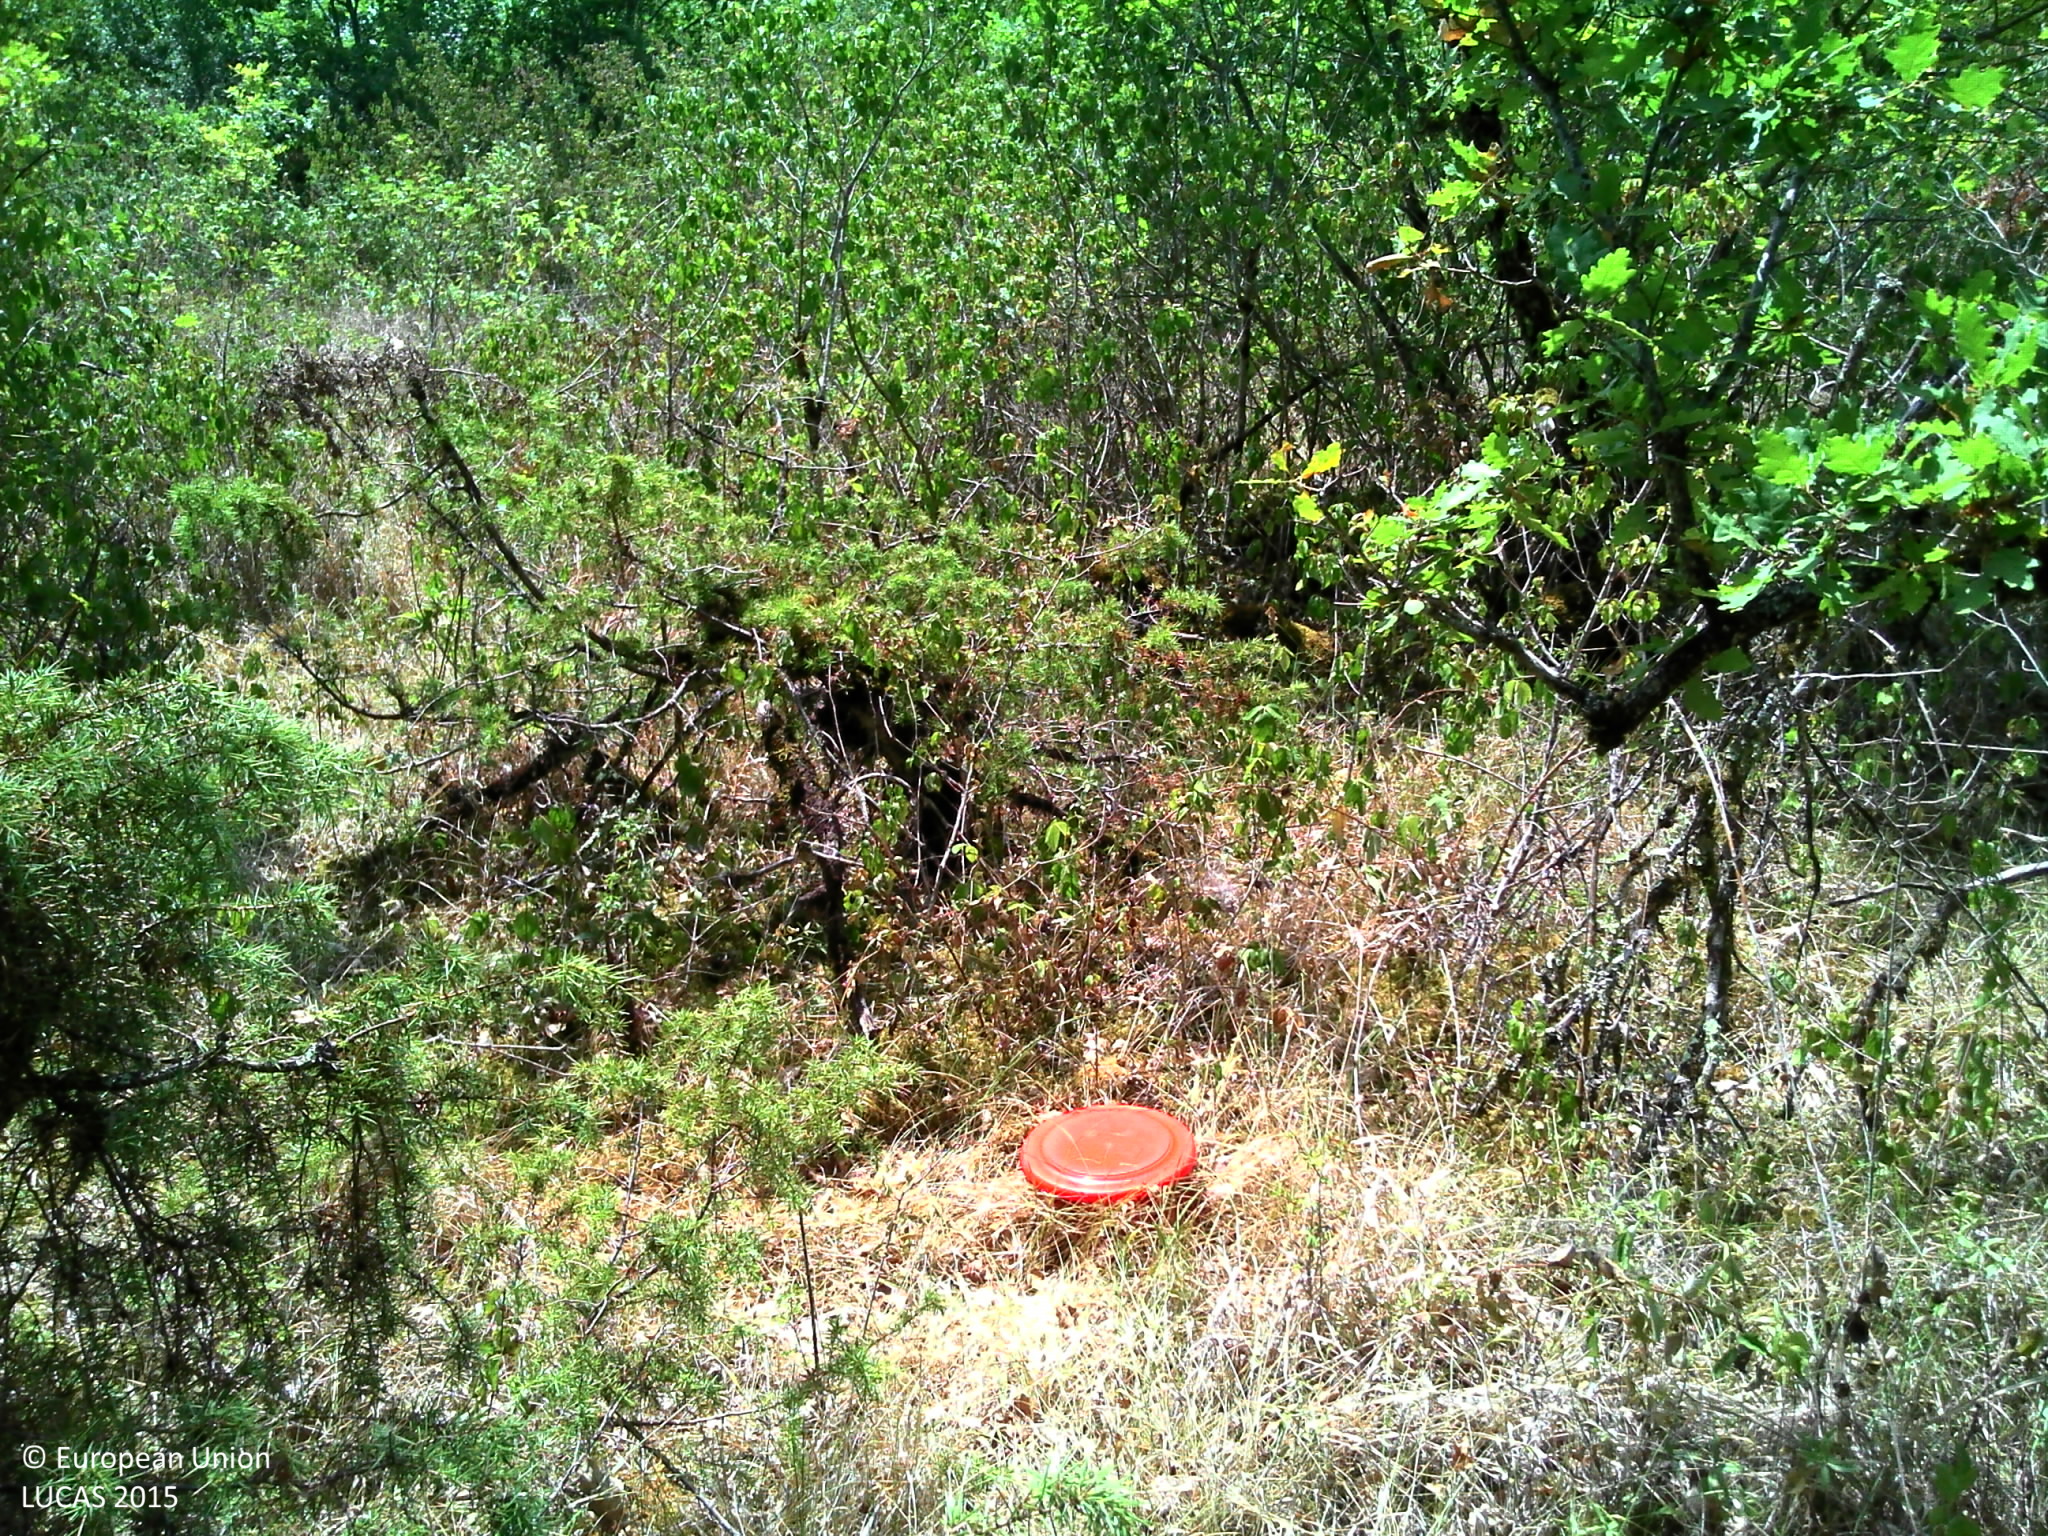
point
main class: Woodland
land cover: Broadleaved woodland
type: acidophilous oak and oak-birch forest
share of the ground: > 75 %
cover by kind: broadleaved forest trees 70 %, herbaceous plants 20 %, shrubs 10 %
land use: Forestry
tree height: > 5 m
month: July
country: FR
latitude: 45.1820
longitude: 1.0970
